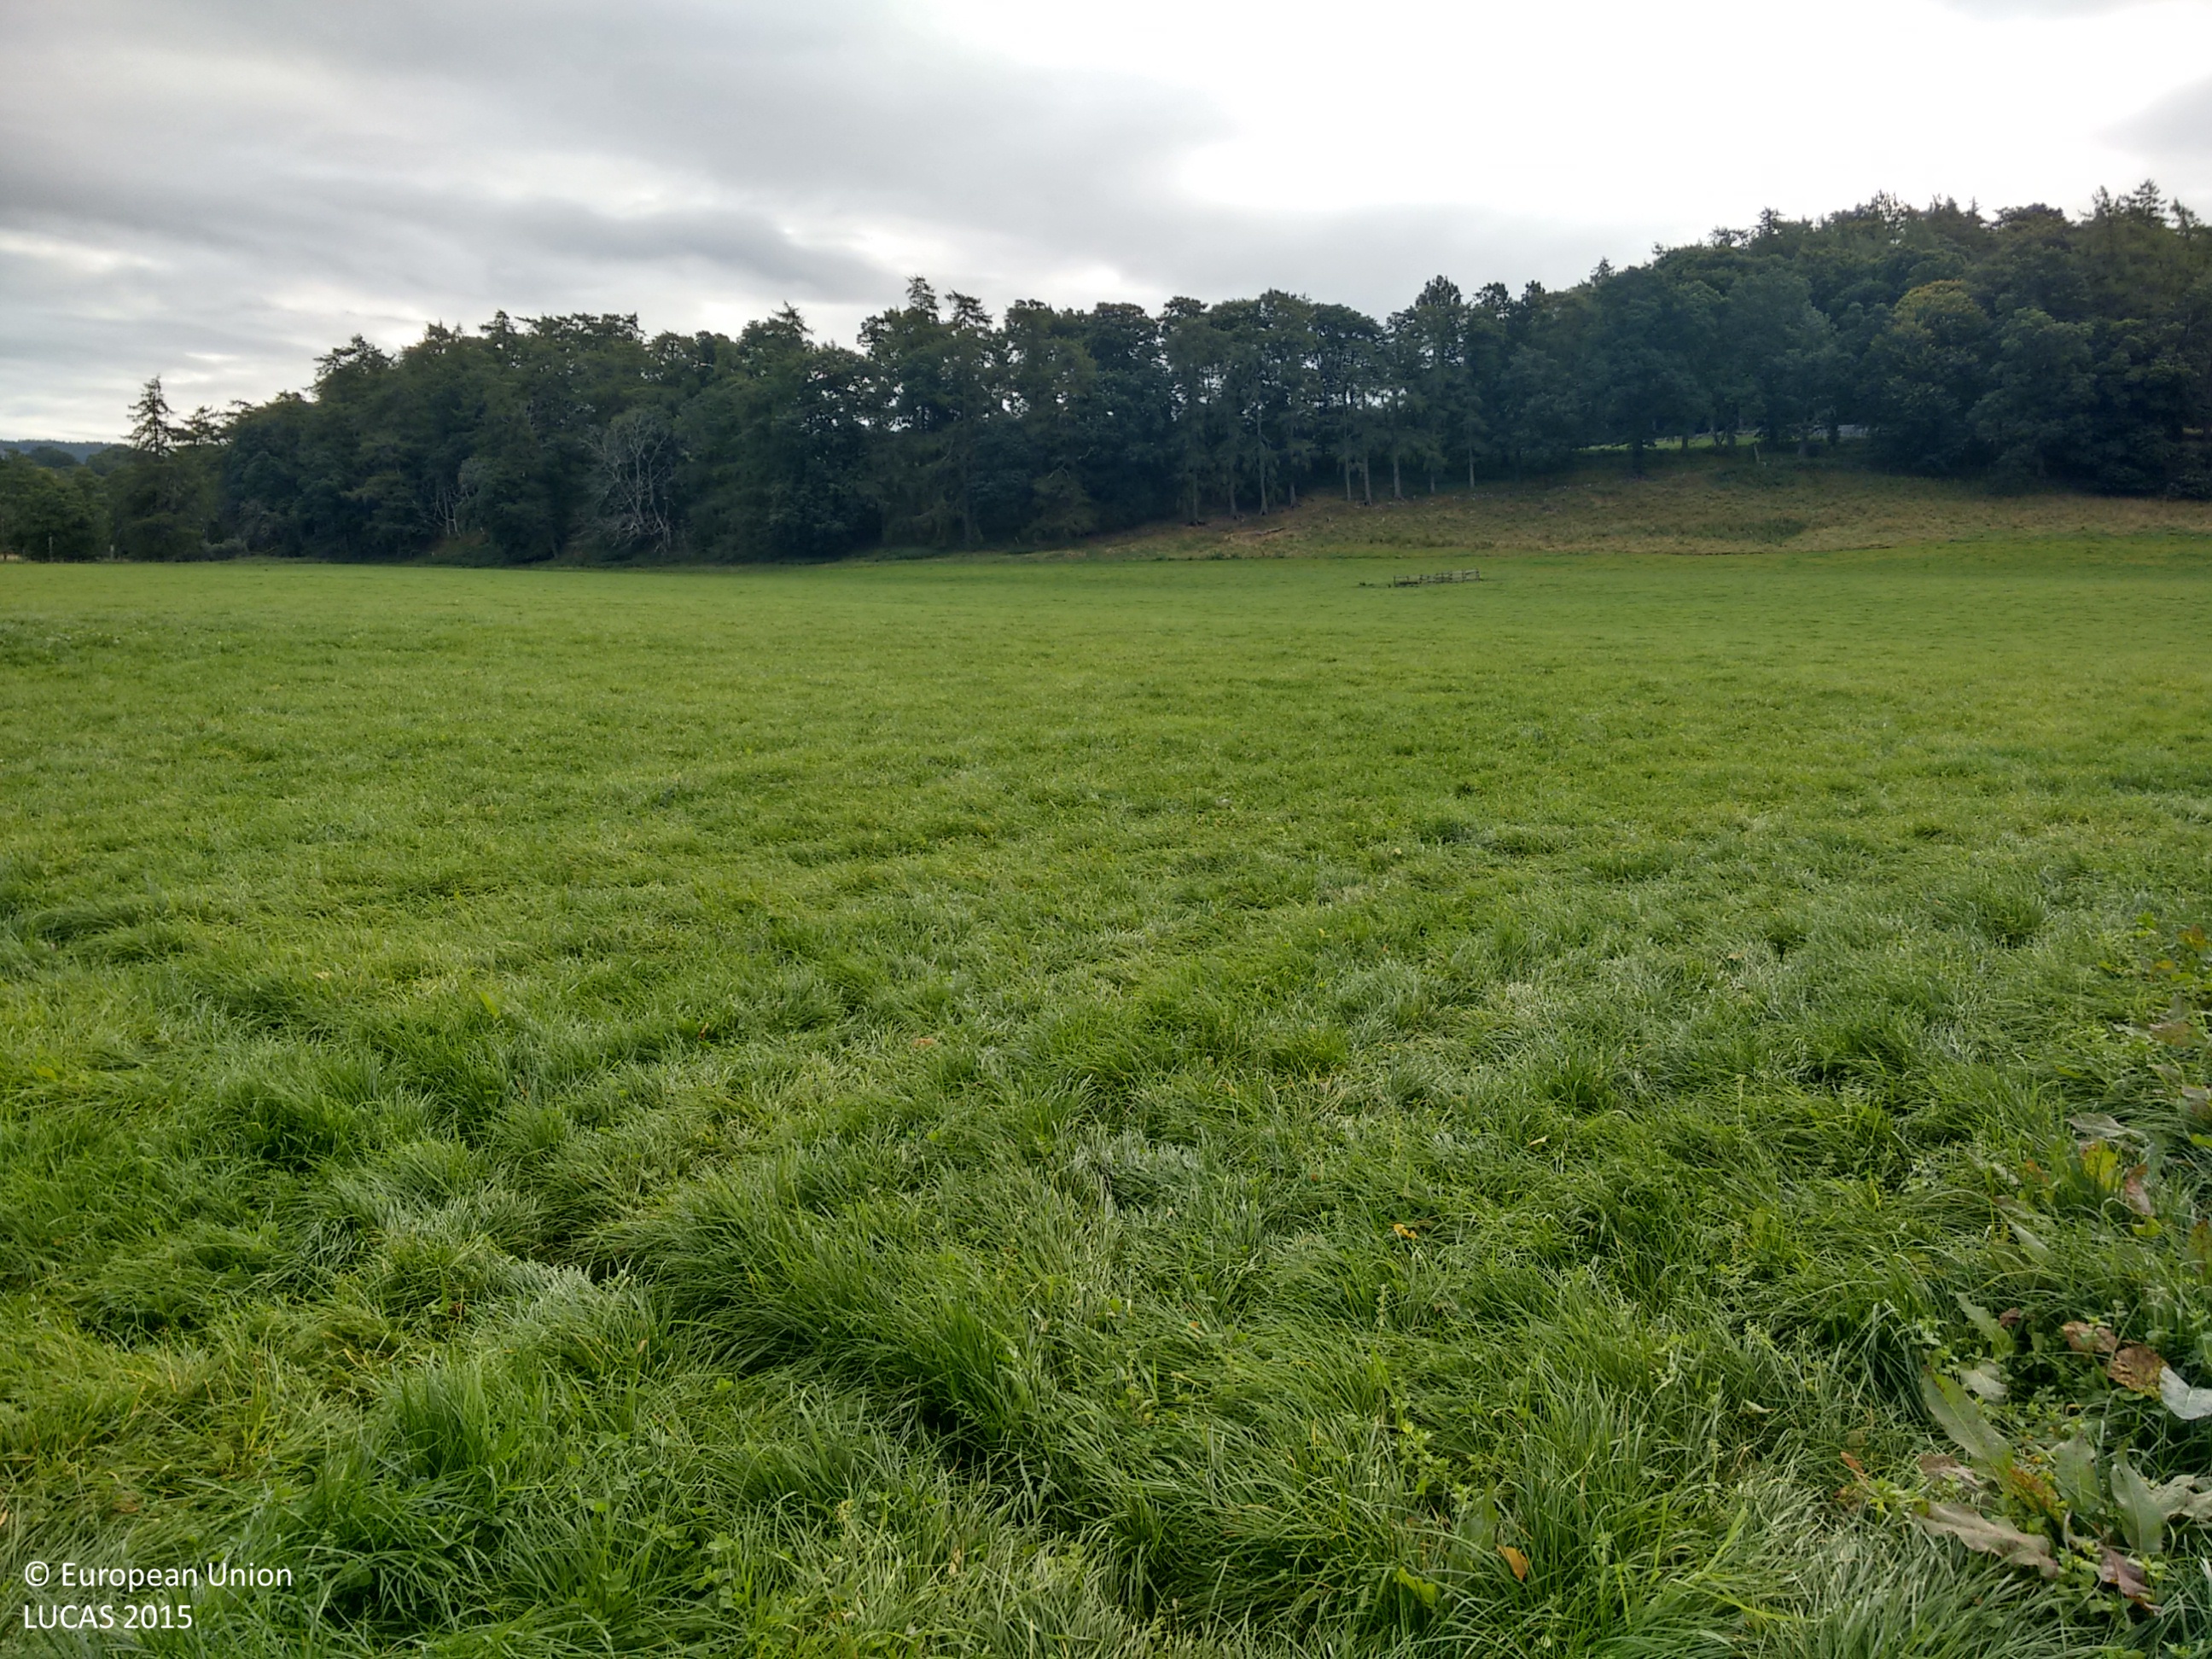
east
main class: Woodland
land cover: Broadleaved woodland
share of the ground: > 75 %
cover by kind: herbaceous plants 65 %, broadleaved forest trees 35 %
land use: Agriculture (excluding fallow land and kitchen gardens)
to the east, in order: Broadleaved woodland; Grassland without tree/shrub cover; Dry stone walls; Other mixed woodland
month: September
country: GB
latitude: 57.4193
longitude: -3.3721
